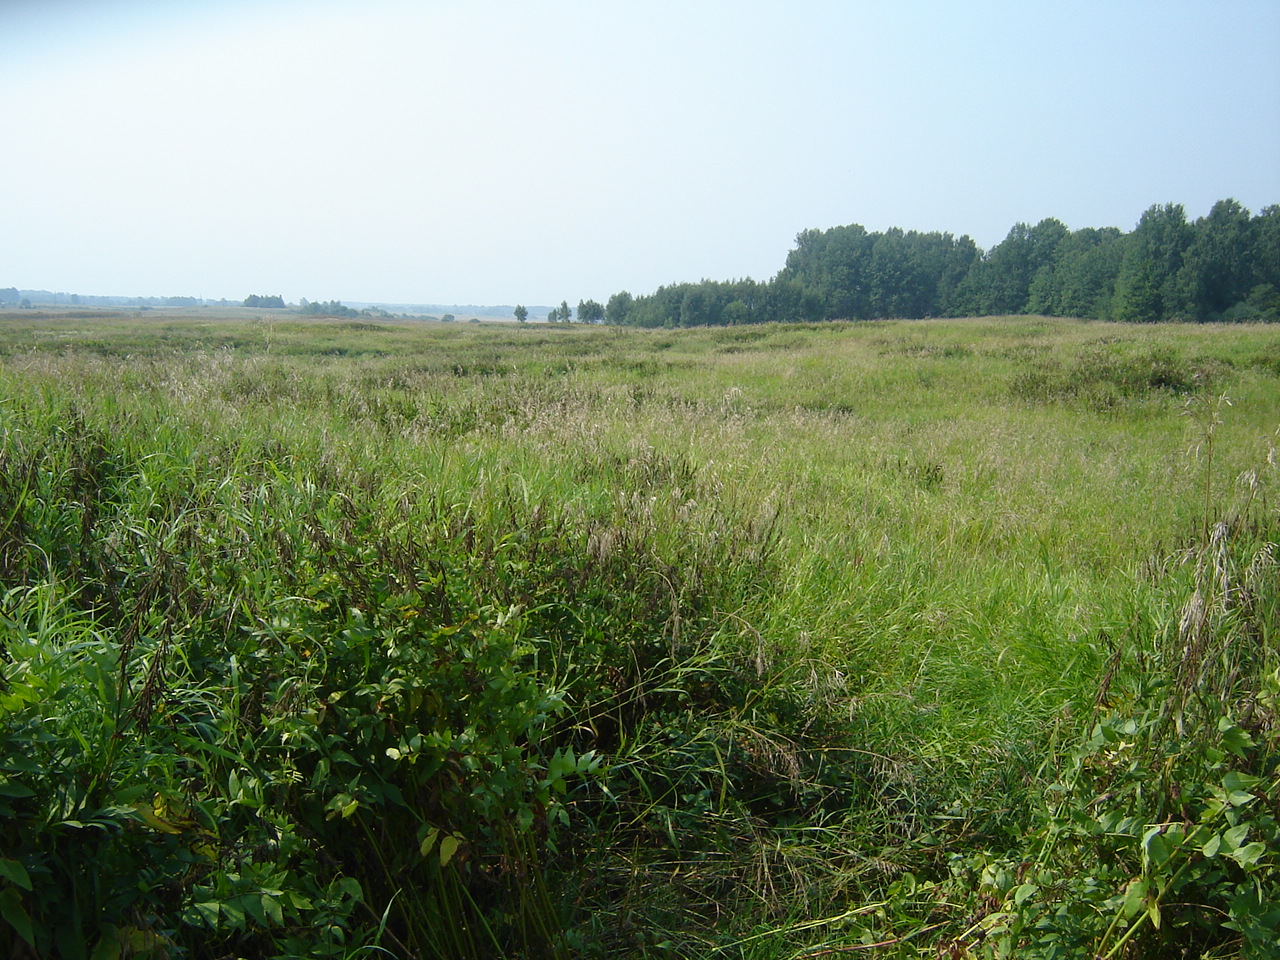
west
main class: Grassland
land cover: Spontaneously vegetated surfaces
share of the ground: > 75 %
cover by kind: herbaceous plants 100 %
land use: Fallow land
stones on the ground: < 10 %
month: August
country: LT
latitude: 54.8738
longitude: 25.0285
